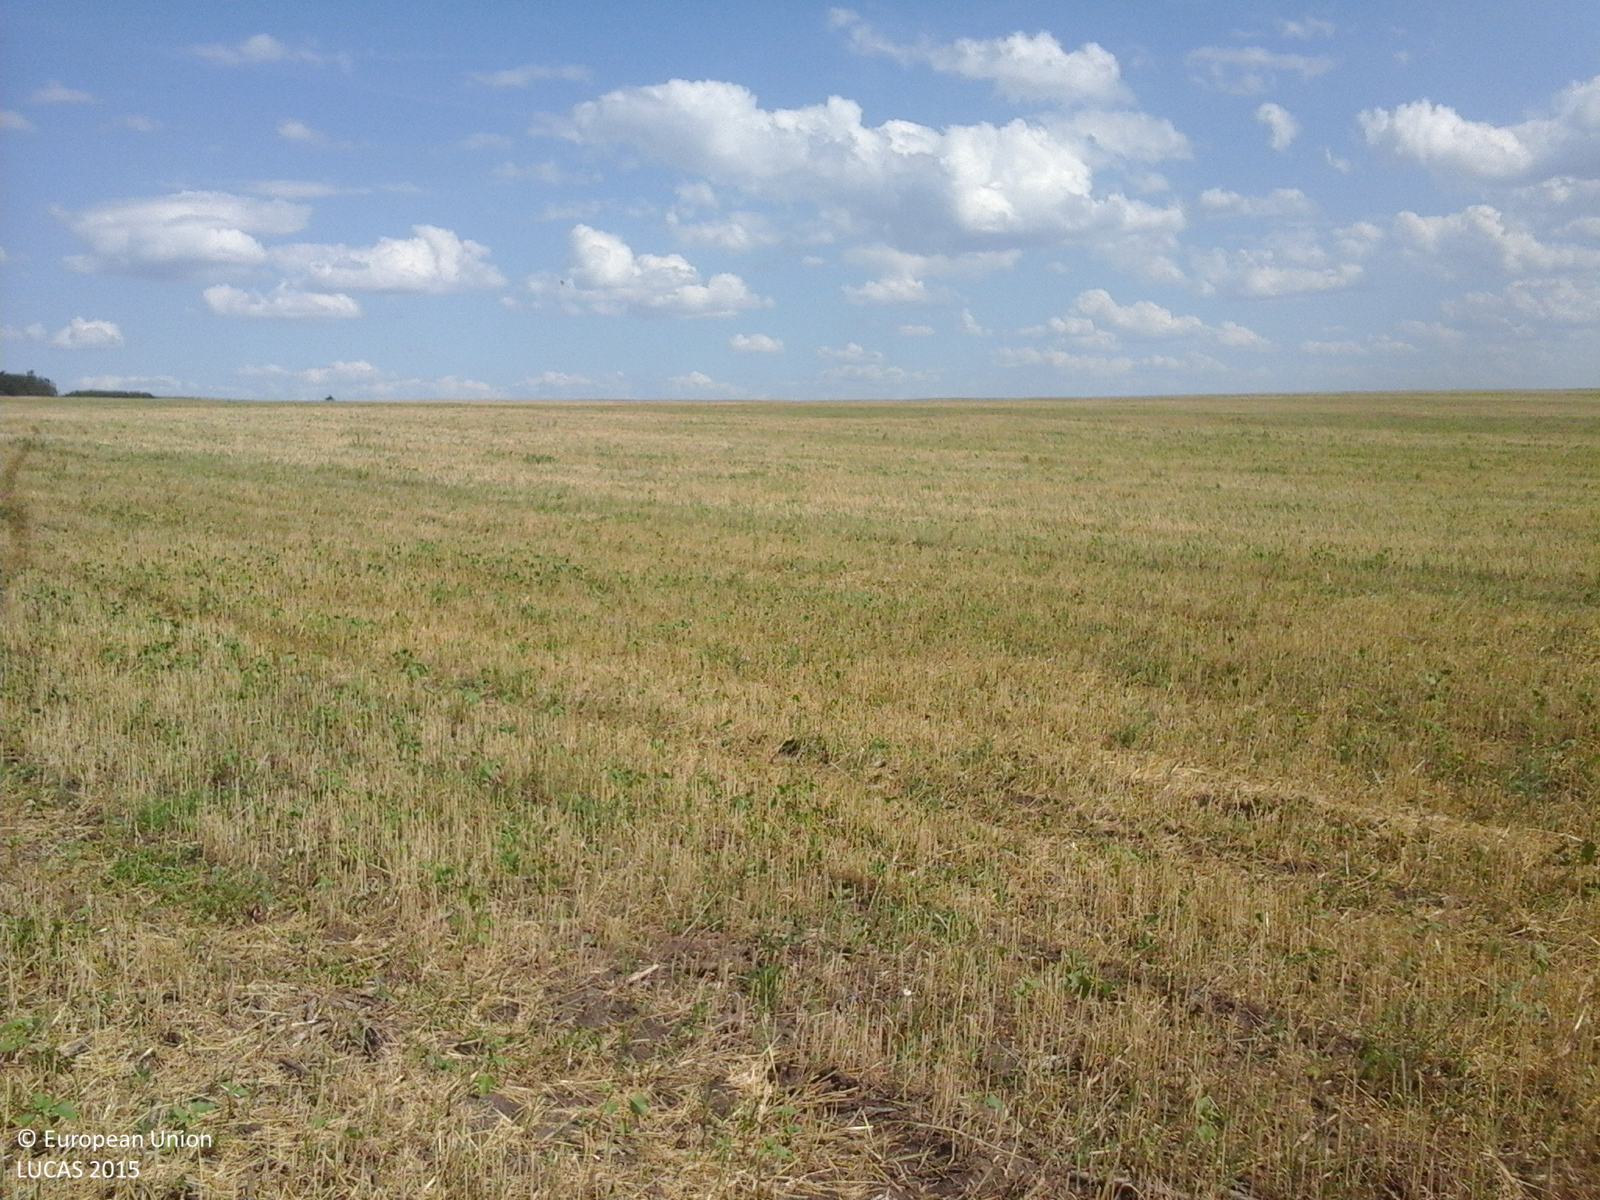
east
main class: Cropland
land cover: Common wheat
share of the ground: 10 - 25 %
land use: Agriculture (excluding fallow land and kitchen gardens)
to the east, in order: Common wheat
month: July
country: RO
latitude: 46.4658
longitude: 27.7904
